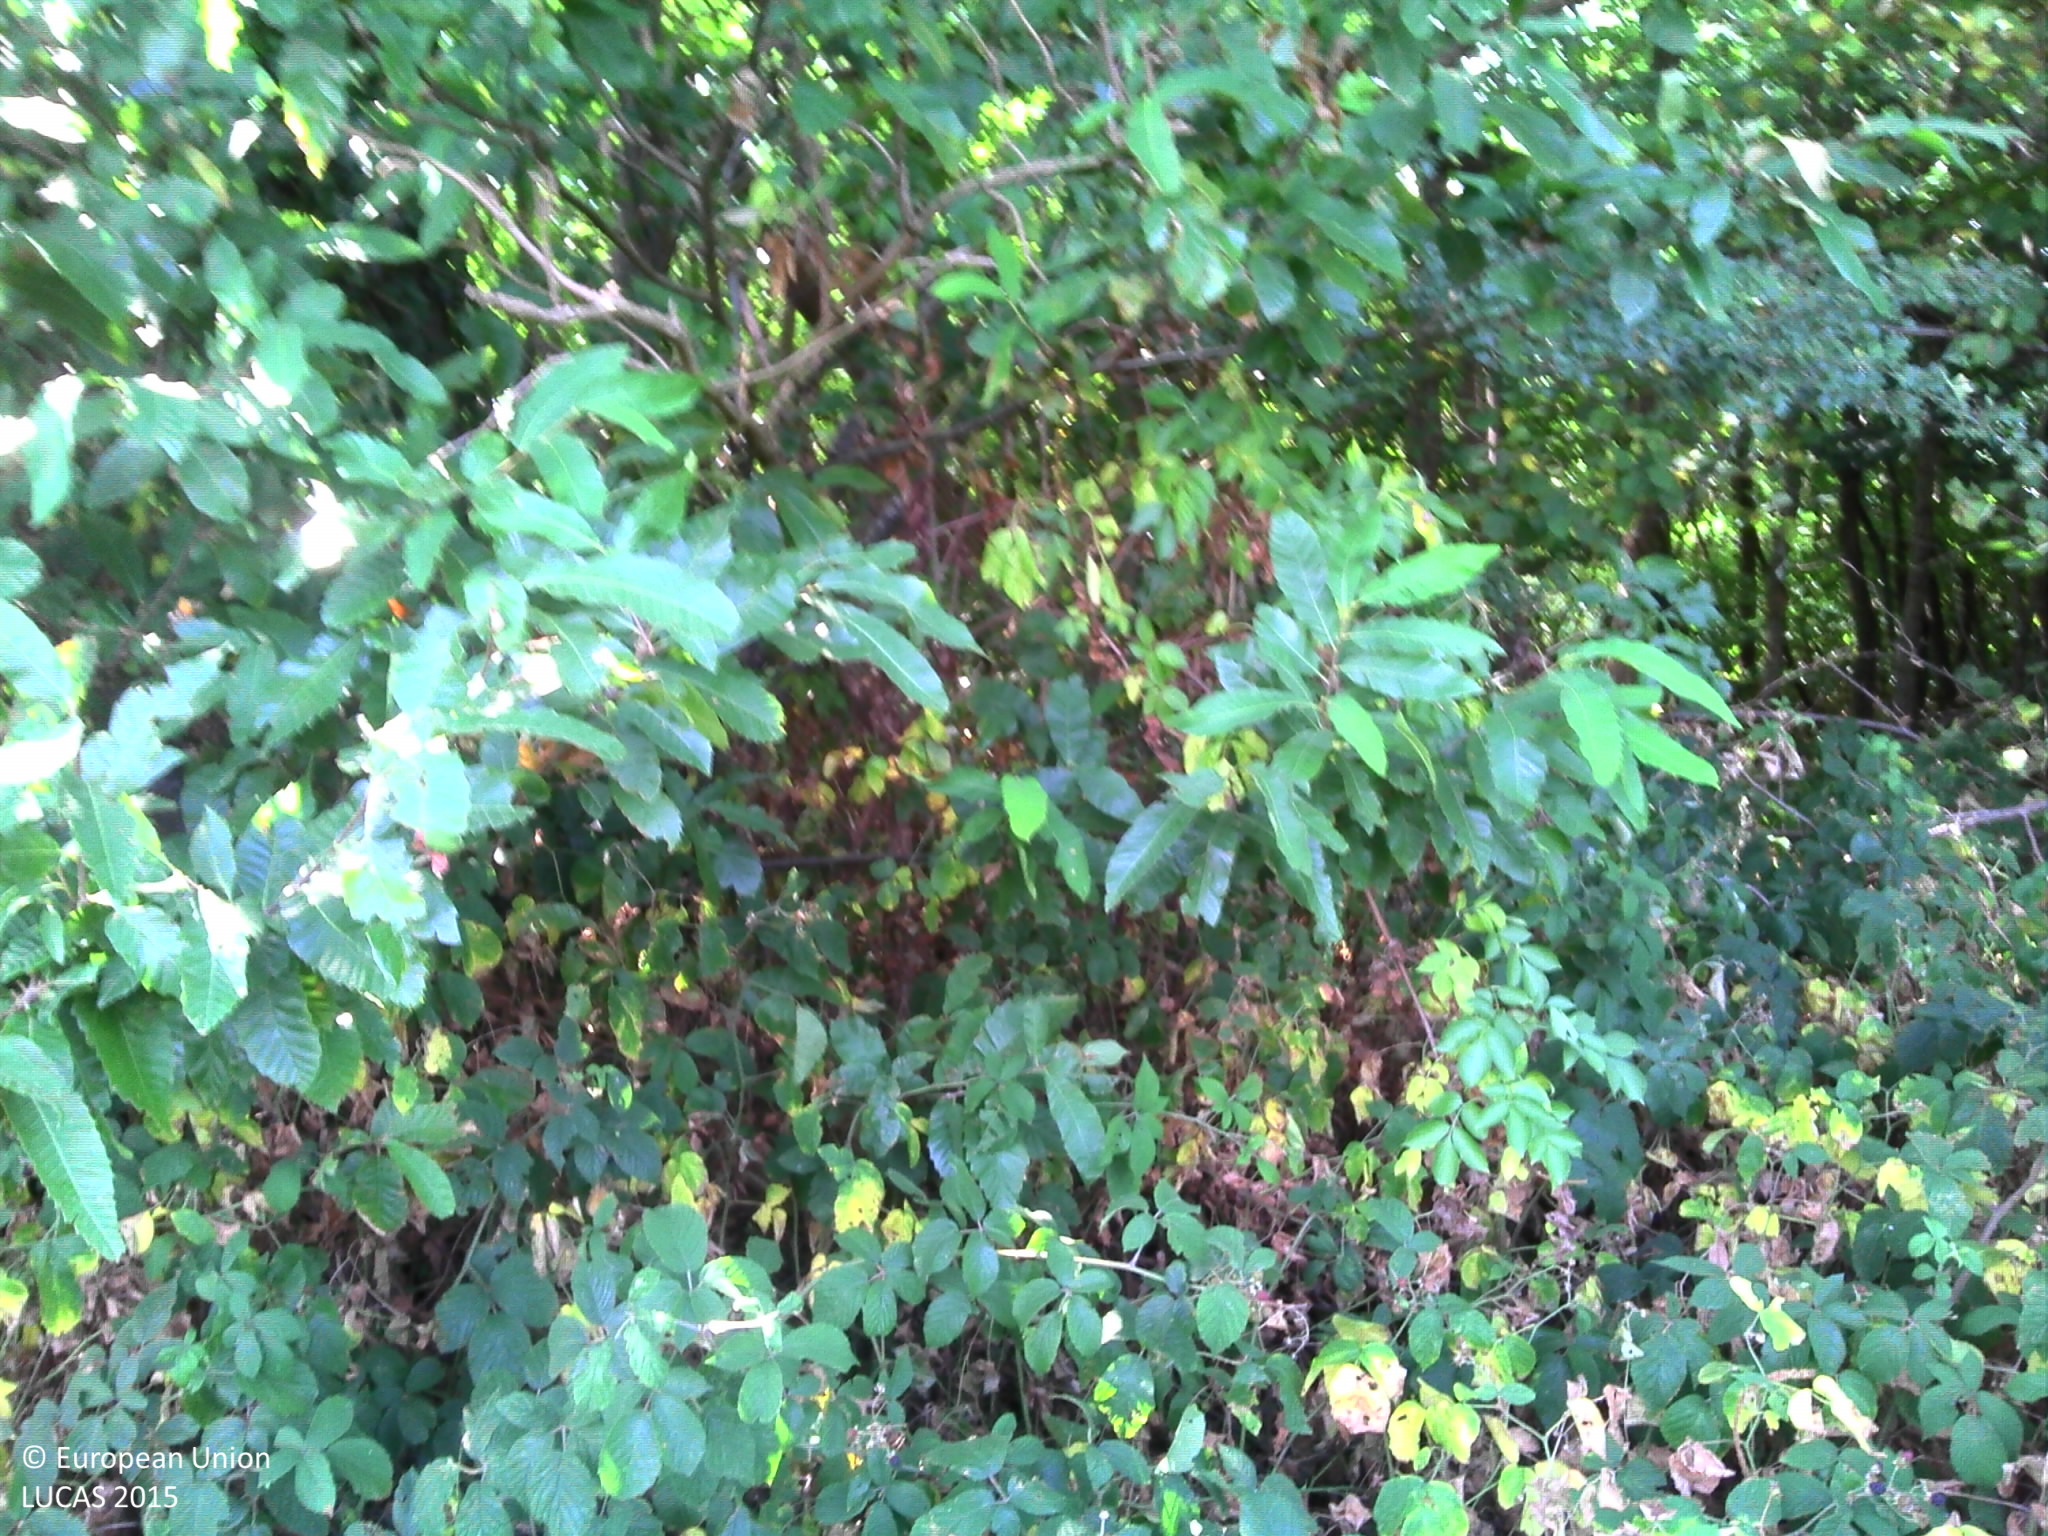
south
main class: Cropland
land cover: Other cereals
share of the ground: > 75 %
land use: Agriculture (excluding fallow land and kitchen gardens)
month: July
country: FR
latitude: 45.3325
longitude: 5.0157
